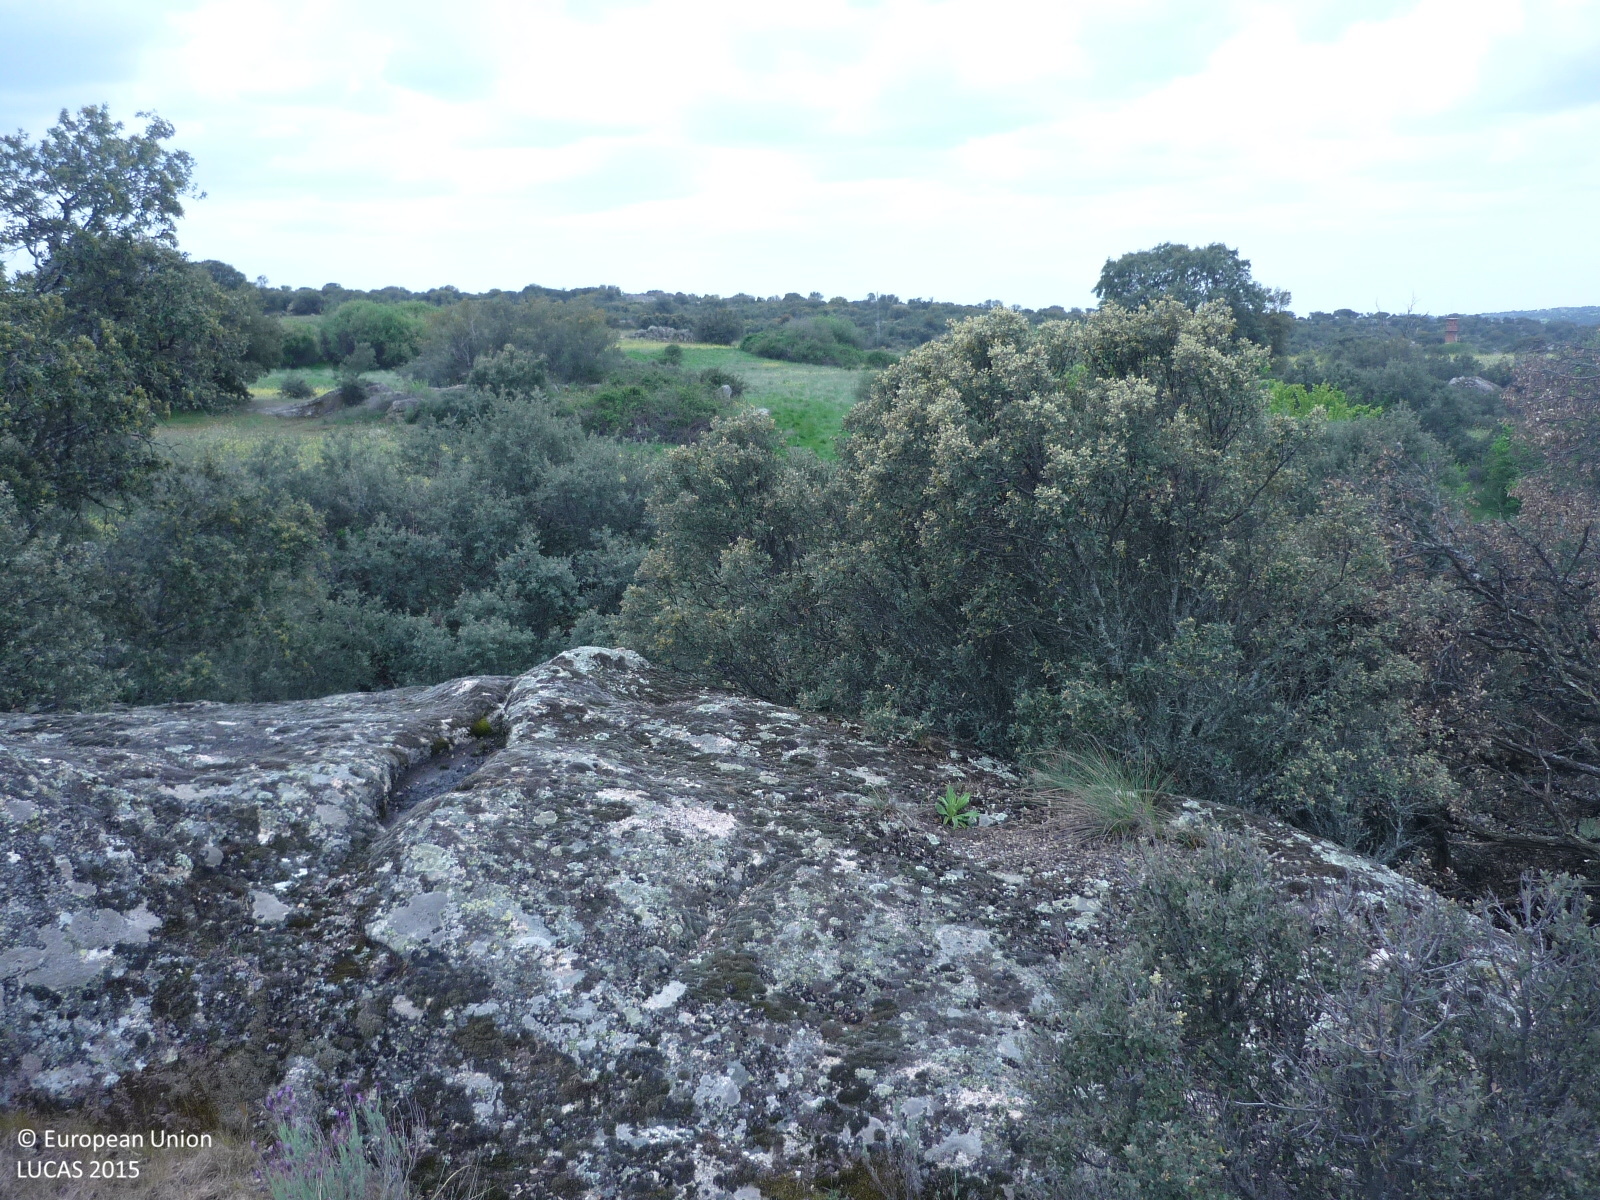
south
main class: Grassland
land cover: Grassland with sparse tree/shrub cover
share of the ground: > 75 %
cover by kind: herbaceous plants 85 %, shrubs 10 %, broadleaved forest trees 5 %
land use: Agriculture (excluding fallow land and kitchen gardens)
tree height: < 5 m
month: April
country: ES
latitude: 40.6790
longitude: -3.8020
